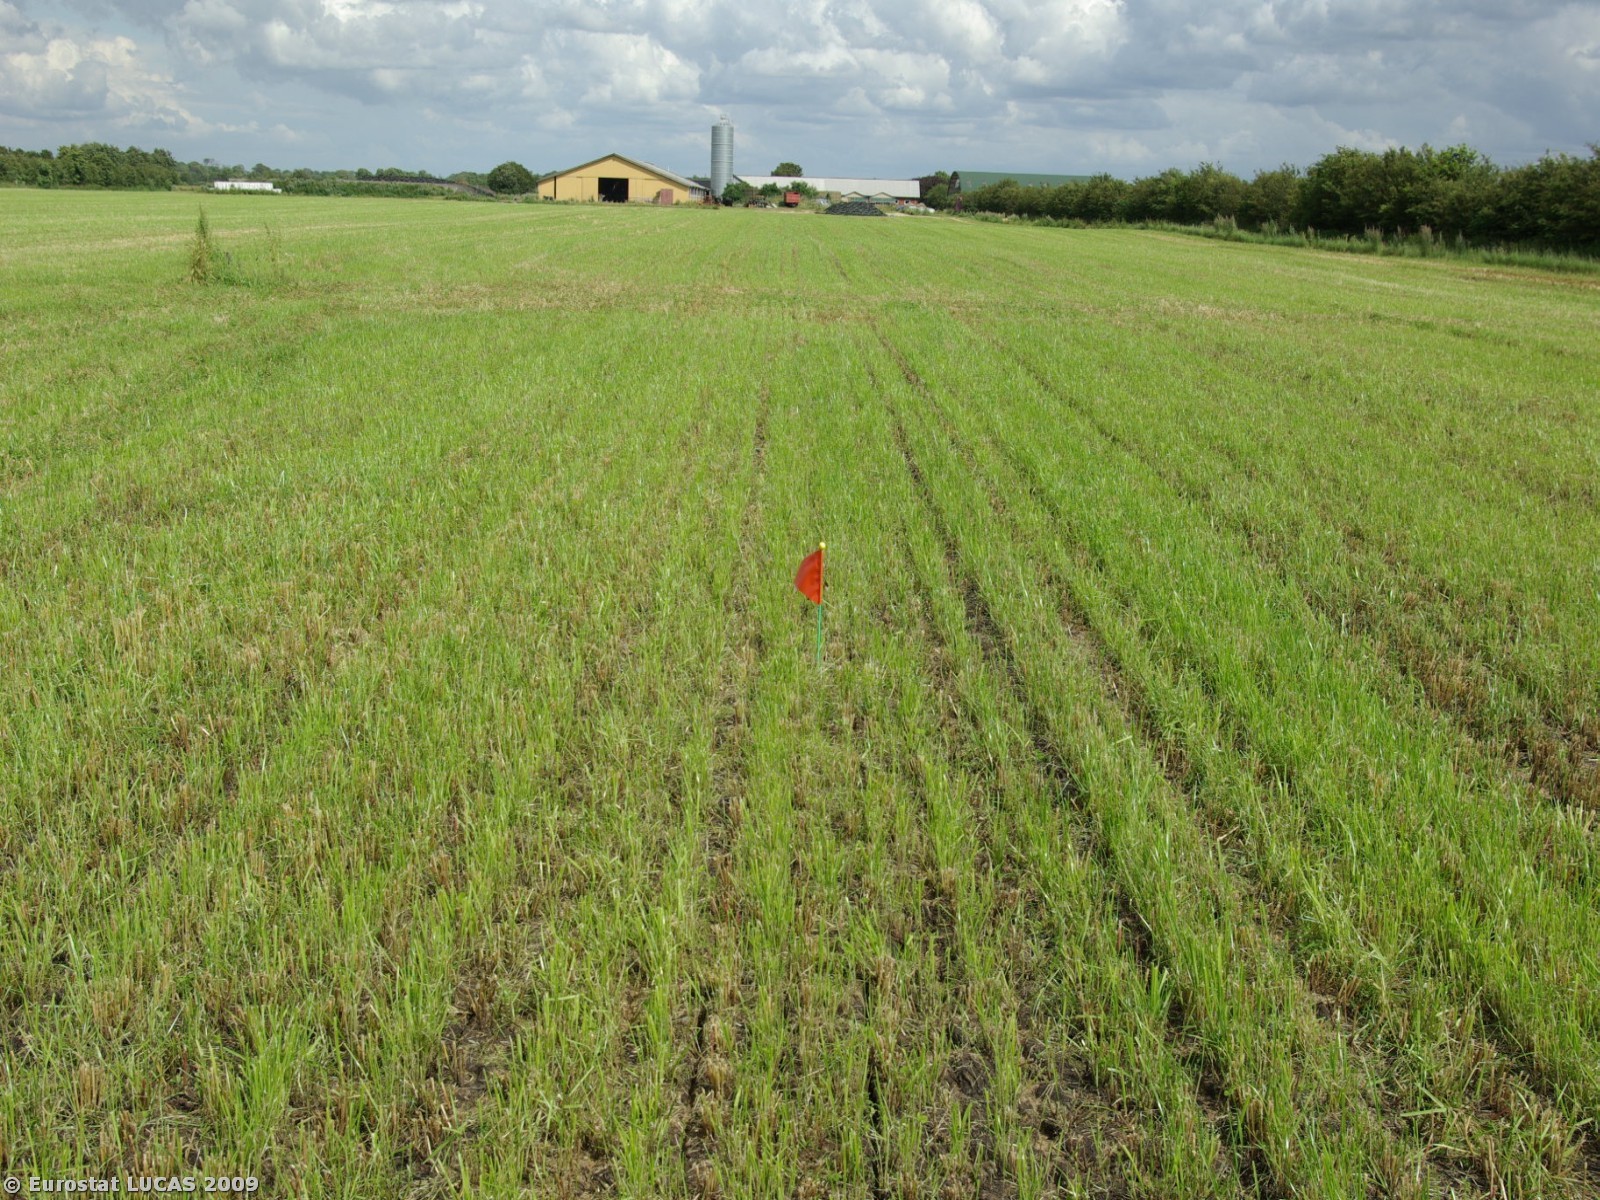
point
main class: Cropland
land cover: Barley
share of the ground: < 10 %
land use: Agriculture (excluding fallow land and kitchen gardens)
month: July
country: DK
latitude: 55.0695
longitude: 9.0142
